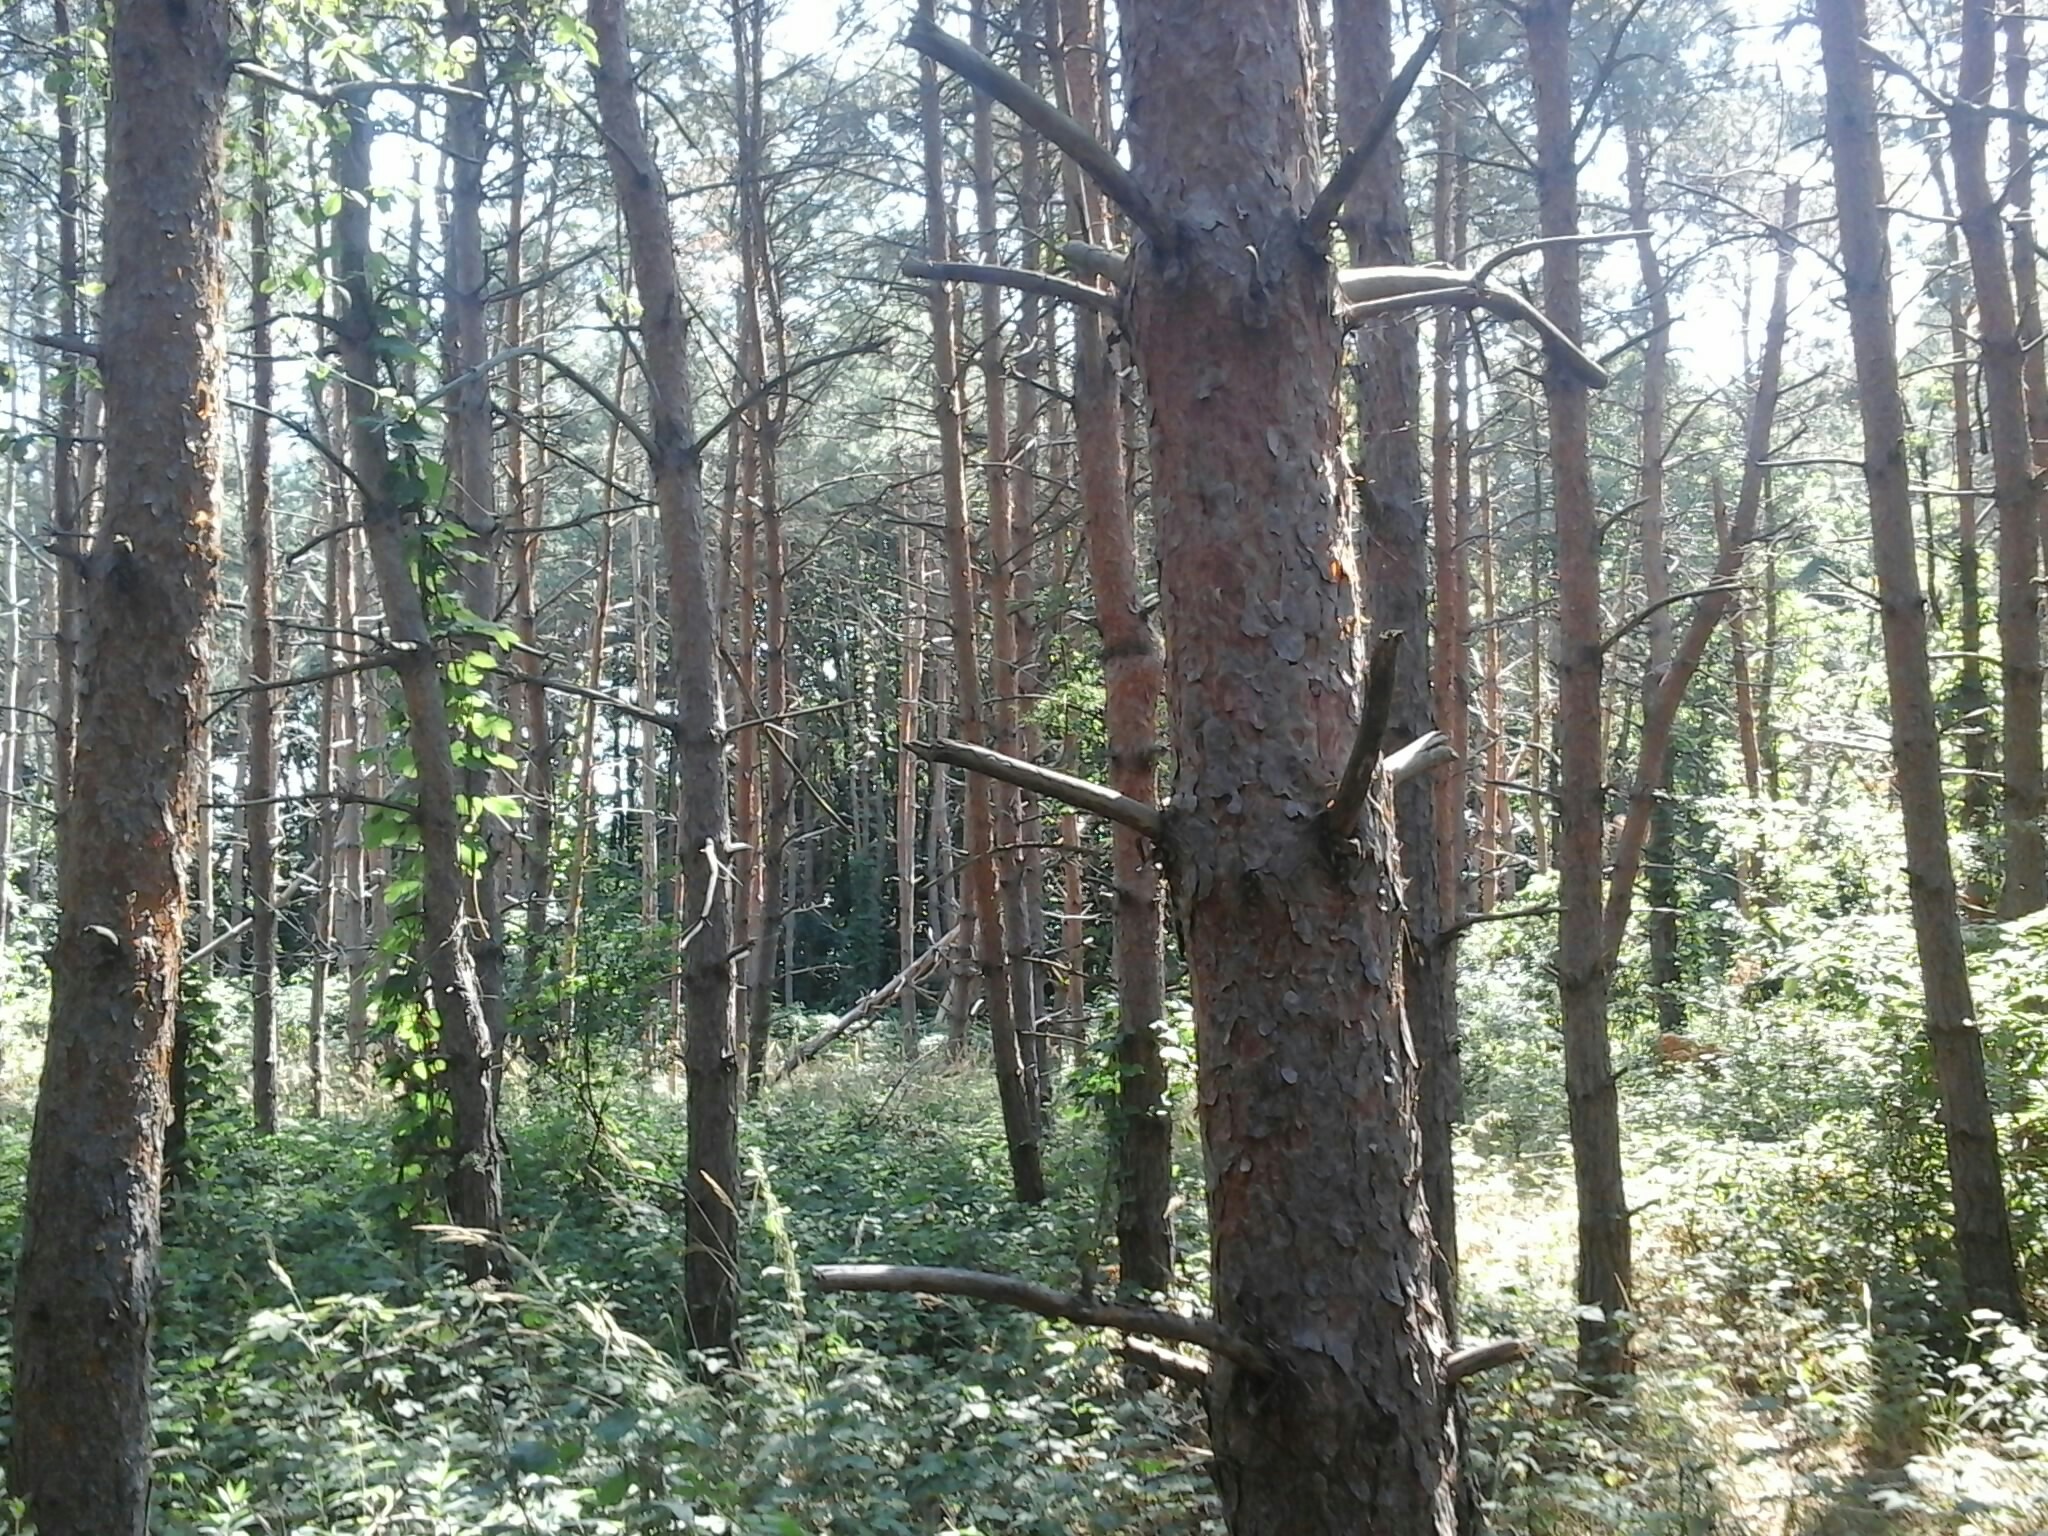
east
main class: Woodland
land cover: Pine dominated coniferous woodland
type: hemiboreal forest and nemoral coniferous forest and mixed broadleaved-coniferous forest
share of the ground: > 75 %
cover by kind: coniferous forest trees 95 %, herbaceous plants 5 %
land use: Forestry
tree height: > 5 m
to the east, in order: Pine dominated coniferous woodland; Grassland without tree/shrub cover; Tracks; Grassland without tree/shrub cover; Tracks; Lucerne
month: August
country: HU
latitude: 47.4297
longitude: 17.9515
